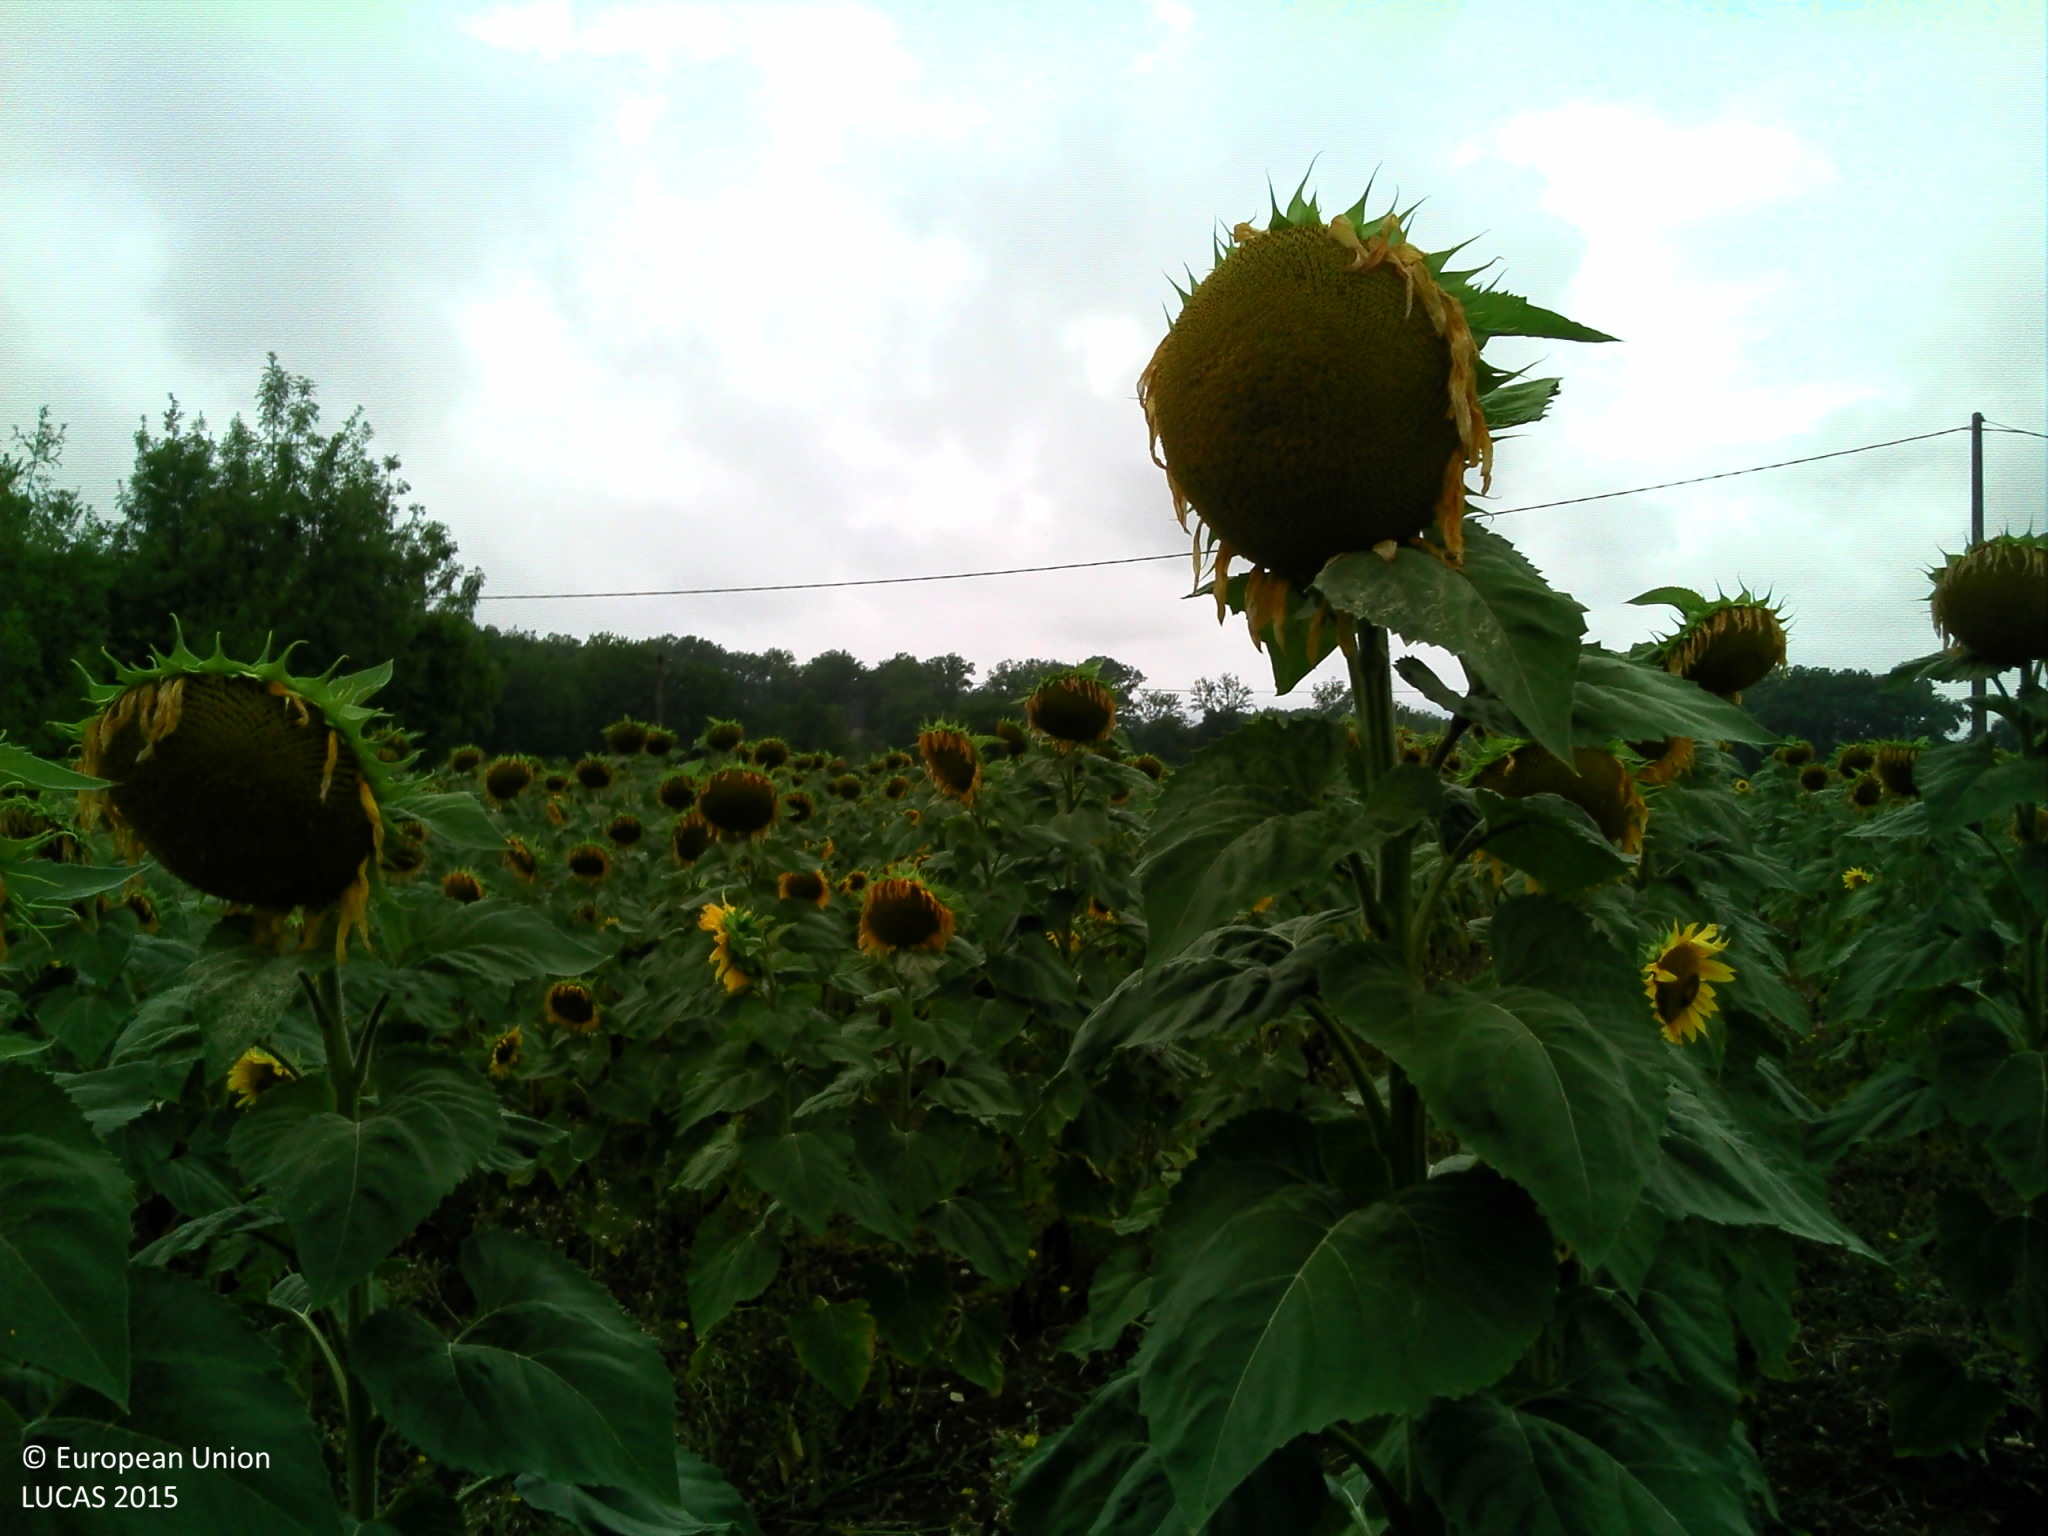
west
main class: Cropland
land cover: Sunflower
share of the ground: 50 - 75 %
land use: Agriculture (excluding fallow land and kitchen gardens)
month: August
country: FR
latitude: 44.6911
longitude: 0.8706
